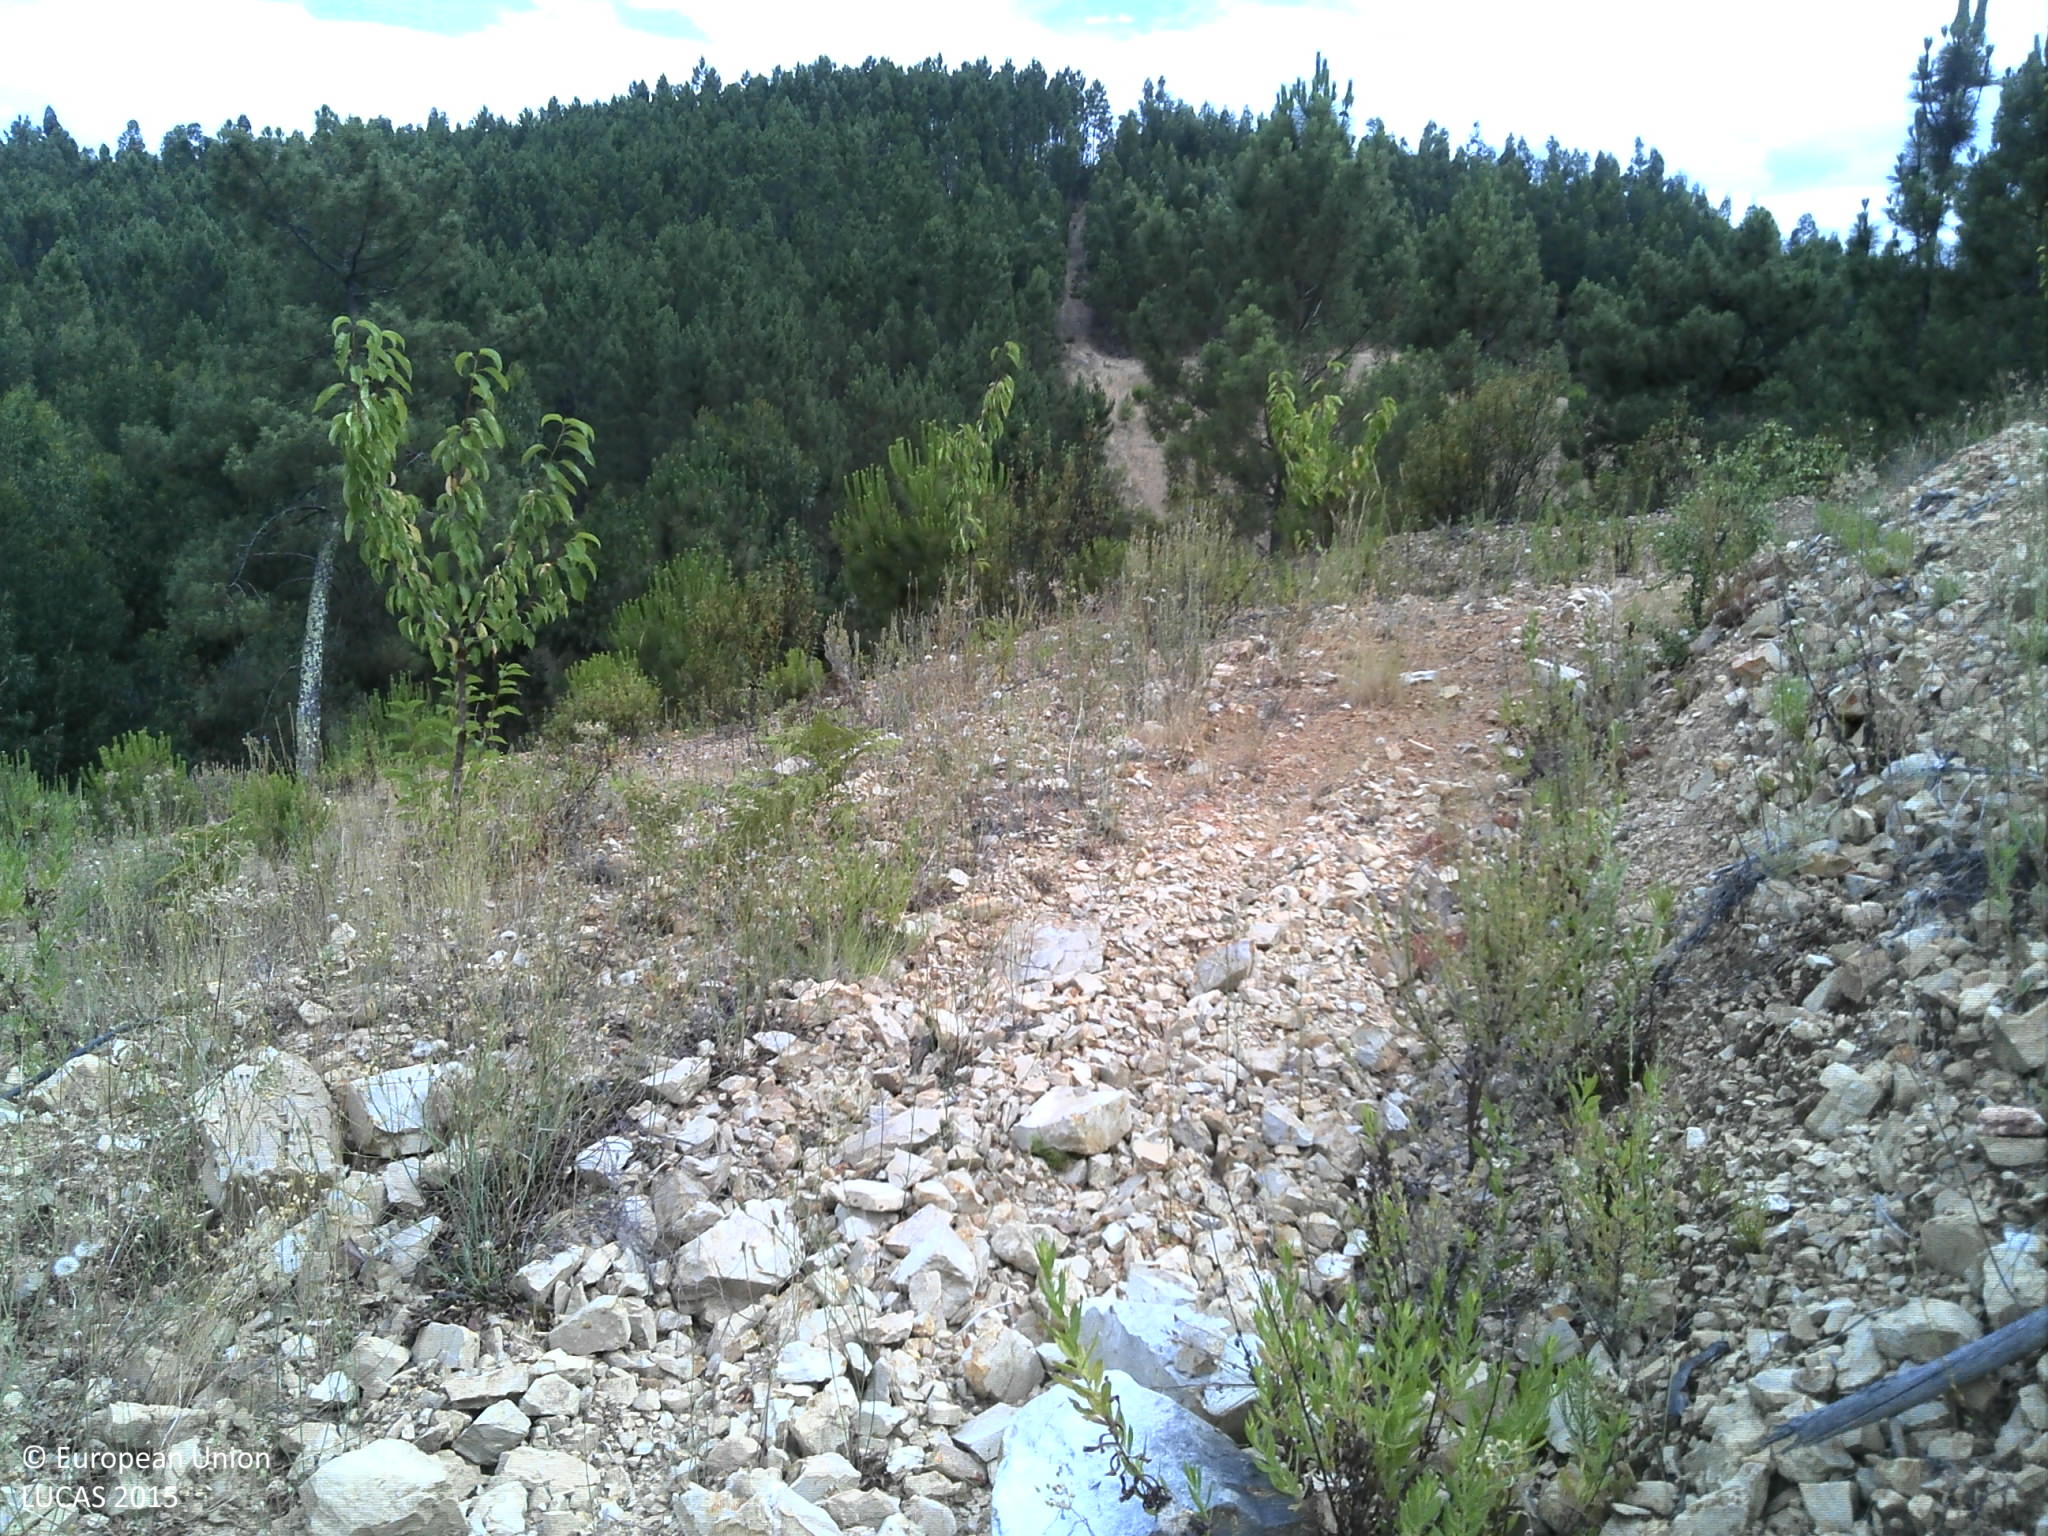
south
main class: Cropland
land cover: Cherry fruit
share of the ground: < 10 %
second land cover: Shrubland without tree cover
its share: 10 - 25 %
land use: Agriculture (excluding fallow land and kitchen gardens)
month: July
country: PT
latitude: 39.6456
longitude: -7.9723
